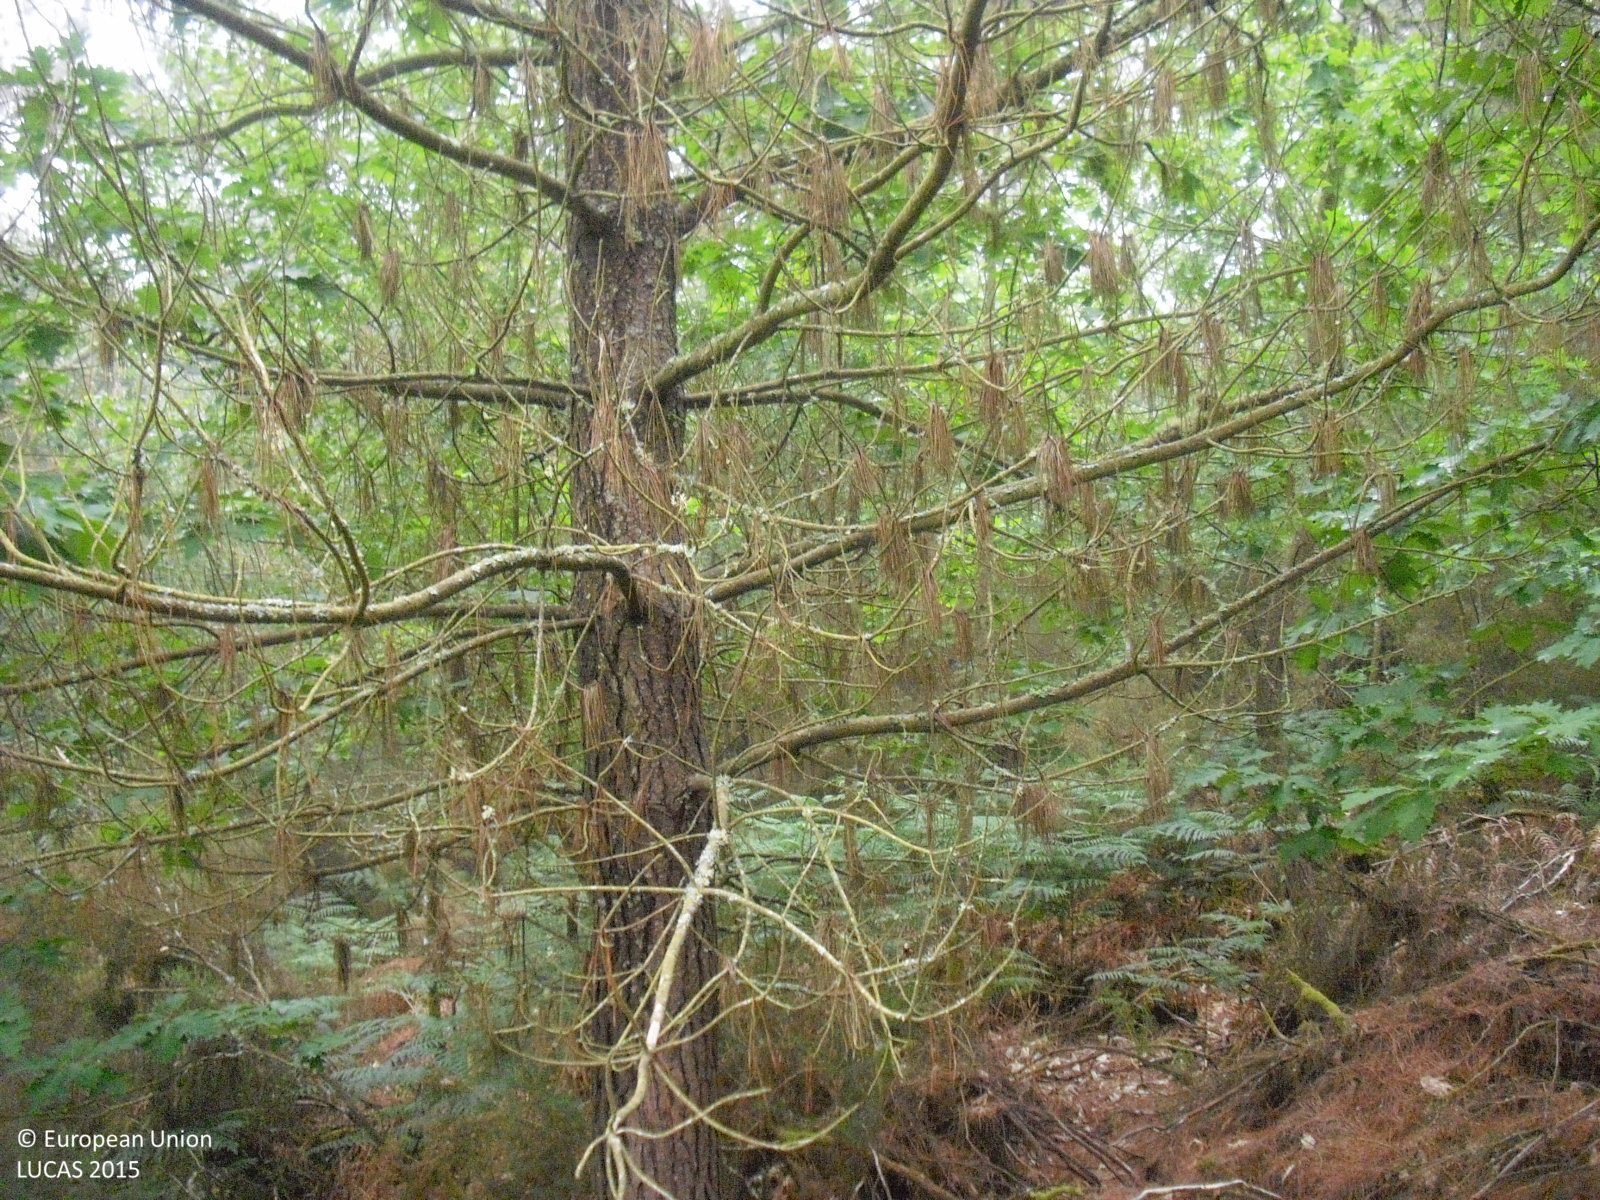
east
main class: Woodland
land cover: Pine dominated mixed woodland
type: hemiboreal forest and nemoral coniferous forest and mixed broadleaved-coniferous forest
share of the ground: 50 - 75 %
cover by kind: coniferous forest trees 40 %, broadleaved forest trees 30 %, shrubs 30 %
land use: Forestry
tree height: > 5 m
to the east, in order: Pine dominated mixed woodland; Broadleaved woodland; Dry stone walls; Tracks; Broadleaved woodland; Rivers and streams; Broadleaved woodland; Shrubland with sparse tree cover; Tracks; Shrubland with sparse tree cover
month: June
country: ES
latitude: 42.6795
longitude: -7.9375
